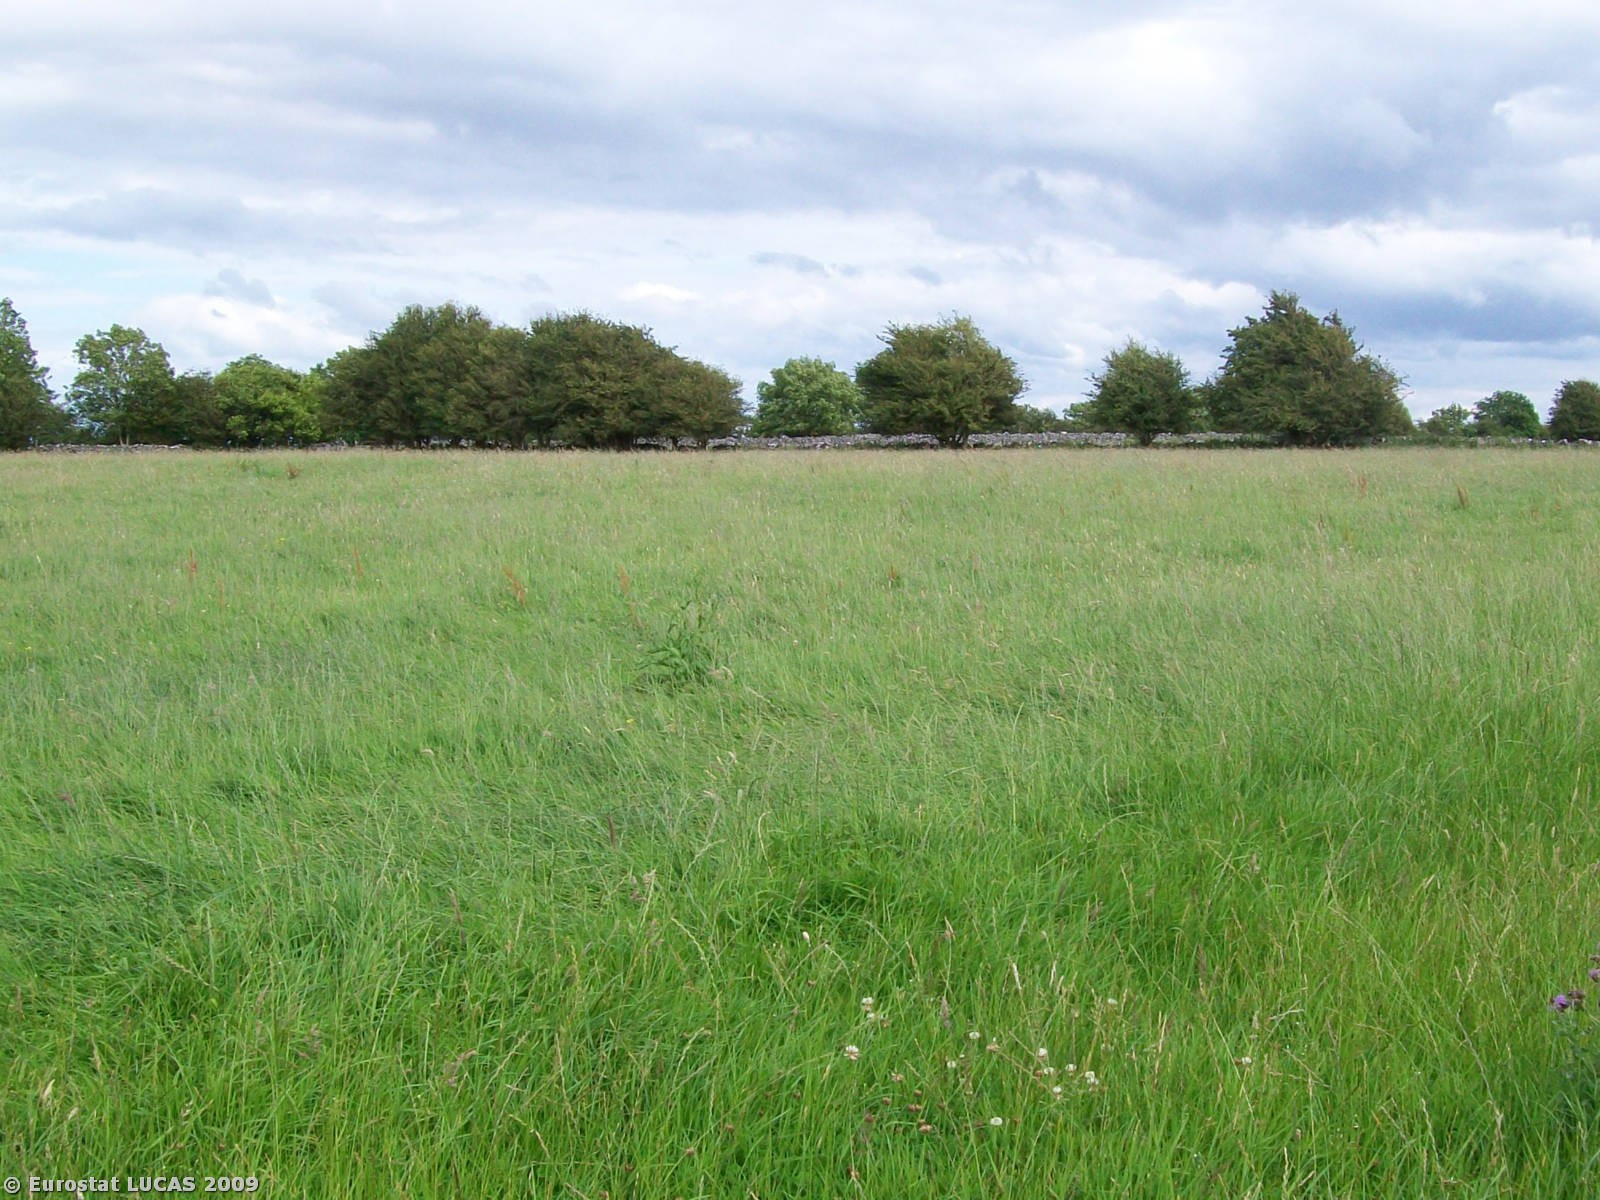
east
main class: Grassland
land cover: Grassland without tree/shrub cover
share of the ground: > 75 %
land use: Agriculture (excluding fallow land and kitchen gardens)
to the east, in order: Grassland without tree/shrub cover; Dry stone walls; Grassland without tree/shrub cover; Dry stone walls; Abandoned hedges; Grassland without tree/shrub cover; Dry stone walls; Grassland without tree/shrub cover
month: July
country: IE
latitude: 53.3147
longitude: -8.8023
